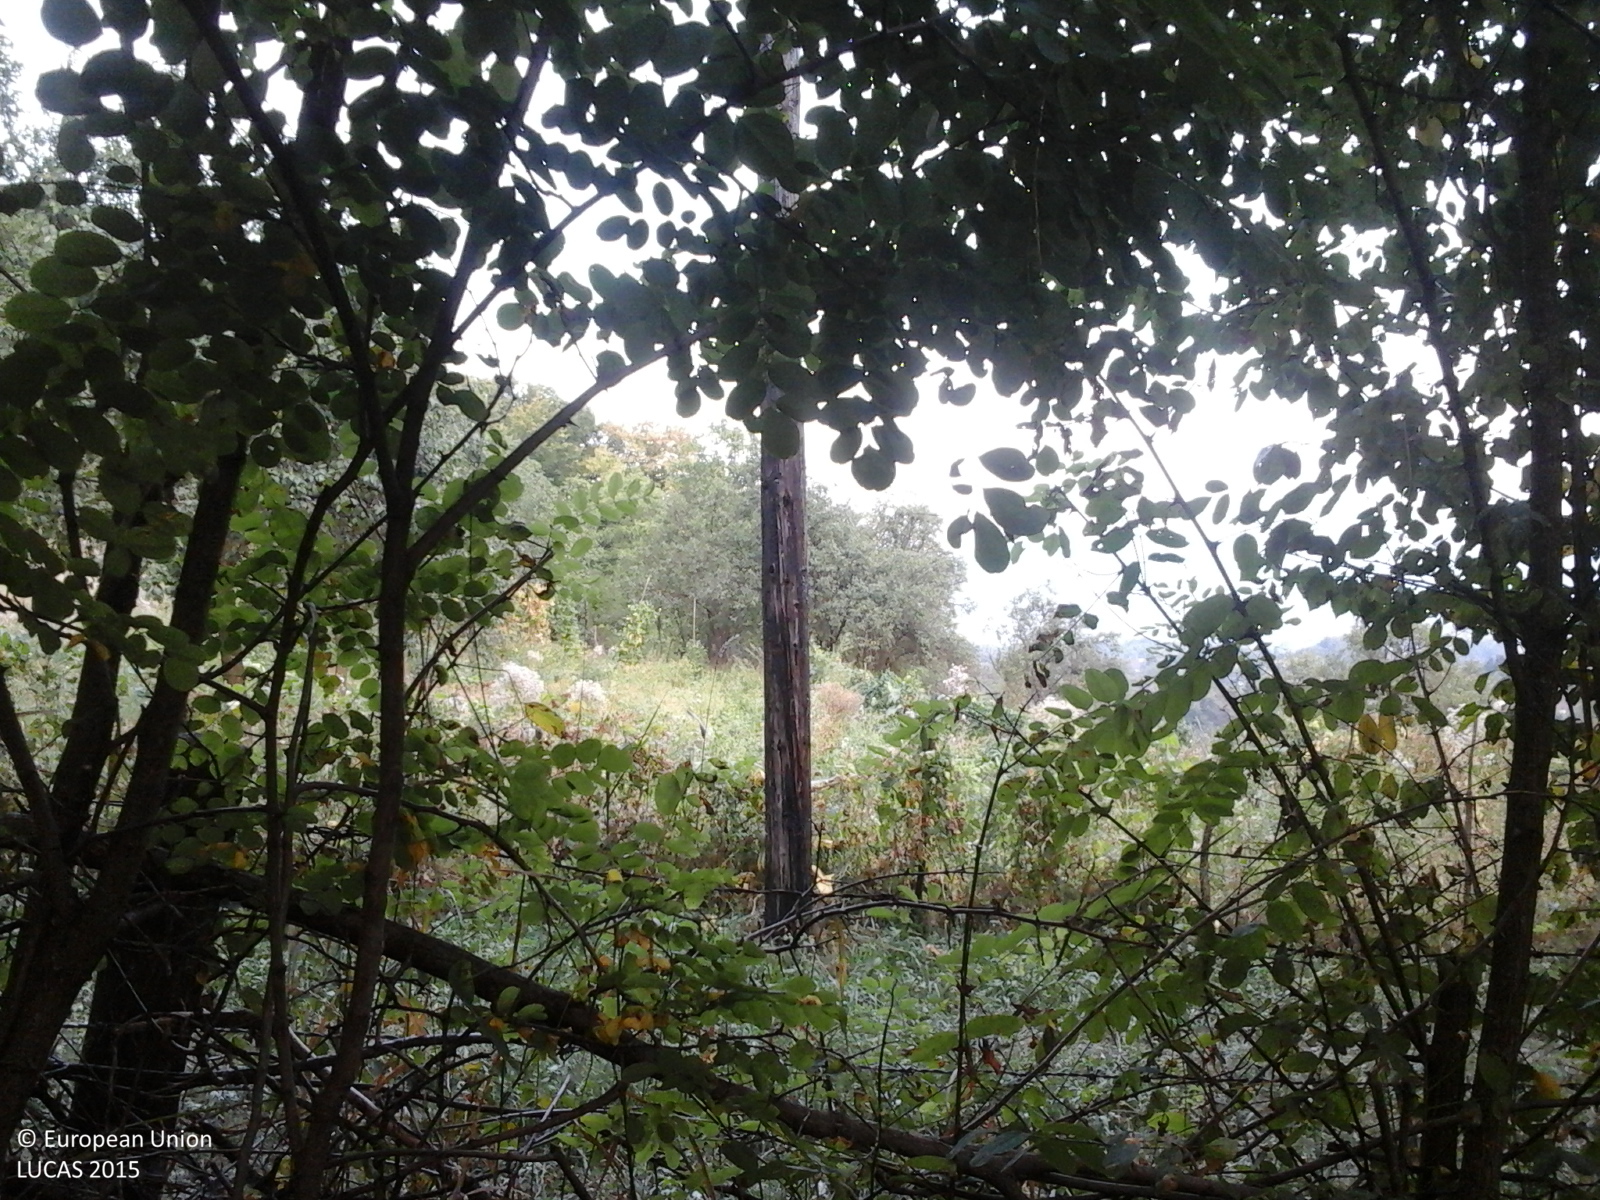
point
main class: Cropland
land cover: Other fruit trees and berries
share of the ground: 10 - 25 %
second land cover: Grassland without tree/shrub cover
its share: > 75 %
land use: Agriculture (excluding fallow land and kitchen gardens)
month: September
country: RO
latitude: 47.7323
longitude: 24.3729
